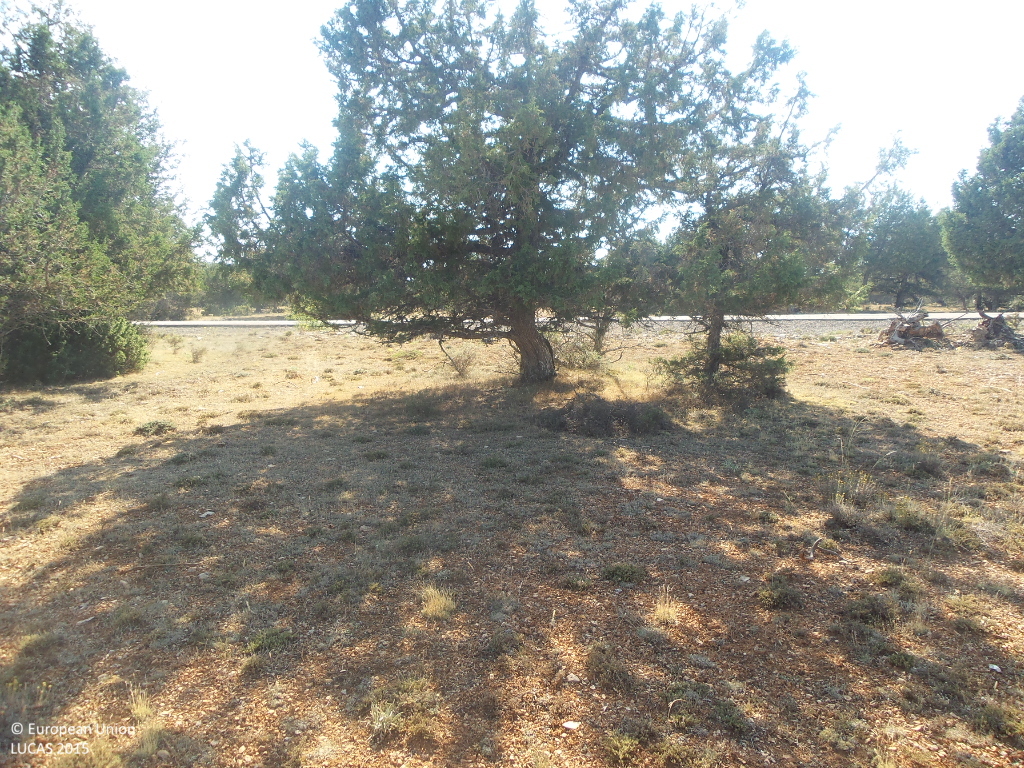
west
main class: Woodland
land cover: Other coniferous woodland
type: coniferous forest of the mediterranean region
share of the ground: 10 - 25 %
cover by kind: unconsolidated bare surface 55 %, coniferous forest trees 20 %, shrubs 20 %, herbaceous plants 5 %
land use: Semi-natural and natural areas not in use
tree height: > 5 m
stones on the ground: < 10 %
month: July
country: ES
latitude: 41.0823
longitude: -2.1328
